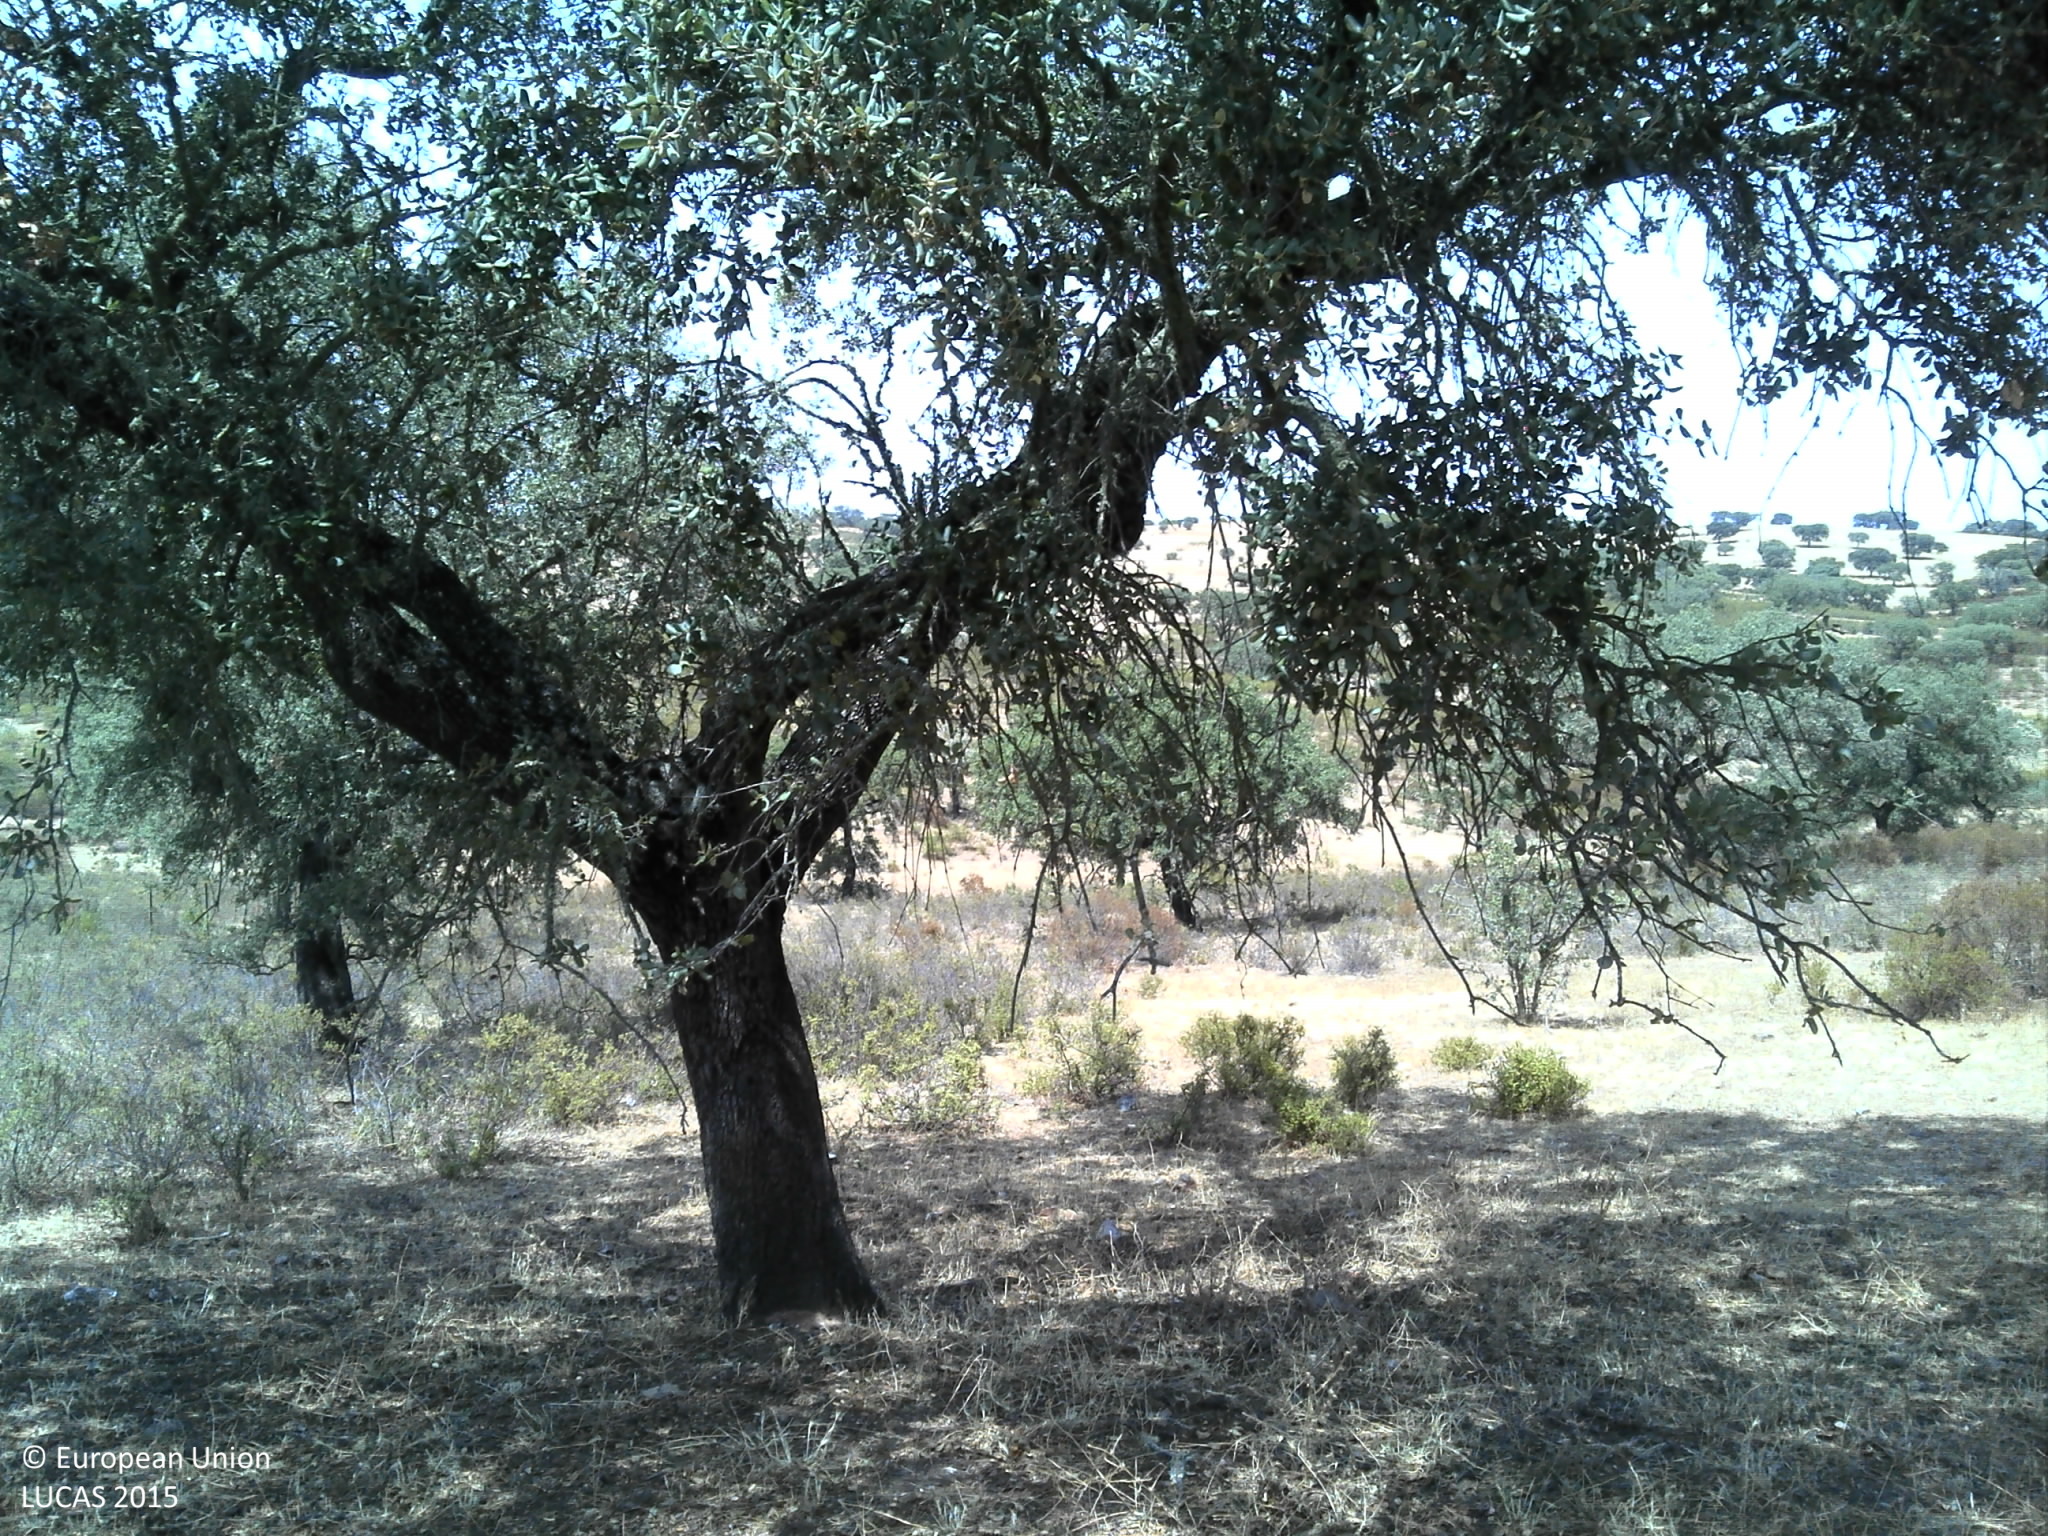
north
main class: Woodland
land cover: Broadleaved woodland
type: broadleaved evergreen forest
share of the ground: 25 - 50 %
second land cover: Grassland without tree/shrub cover
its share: 10 - 25 %
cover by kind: broadleaved forest trees 35 %, unconsolidated bare surface 35 %, herbaceous plants 20 %, shrubs 5 %
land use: Forestry
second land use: Agriculture (excluding fallow land and kitchen gardens)
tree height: > 5 m
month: July
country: PT
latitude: 37.7588
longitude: -7.7848
